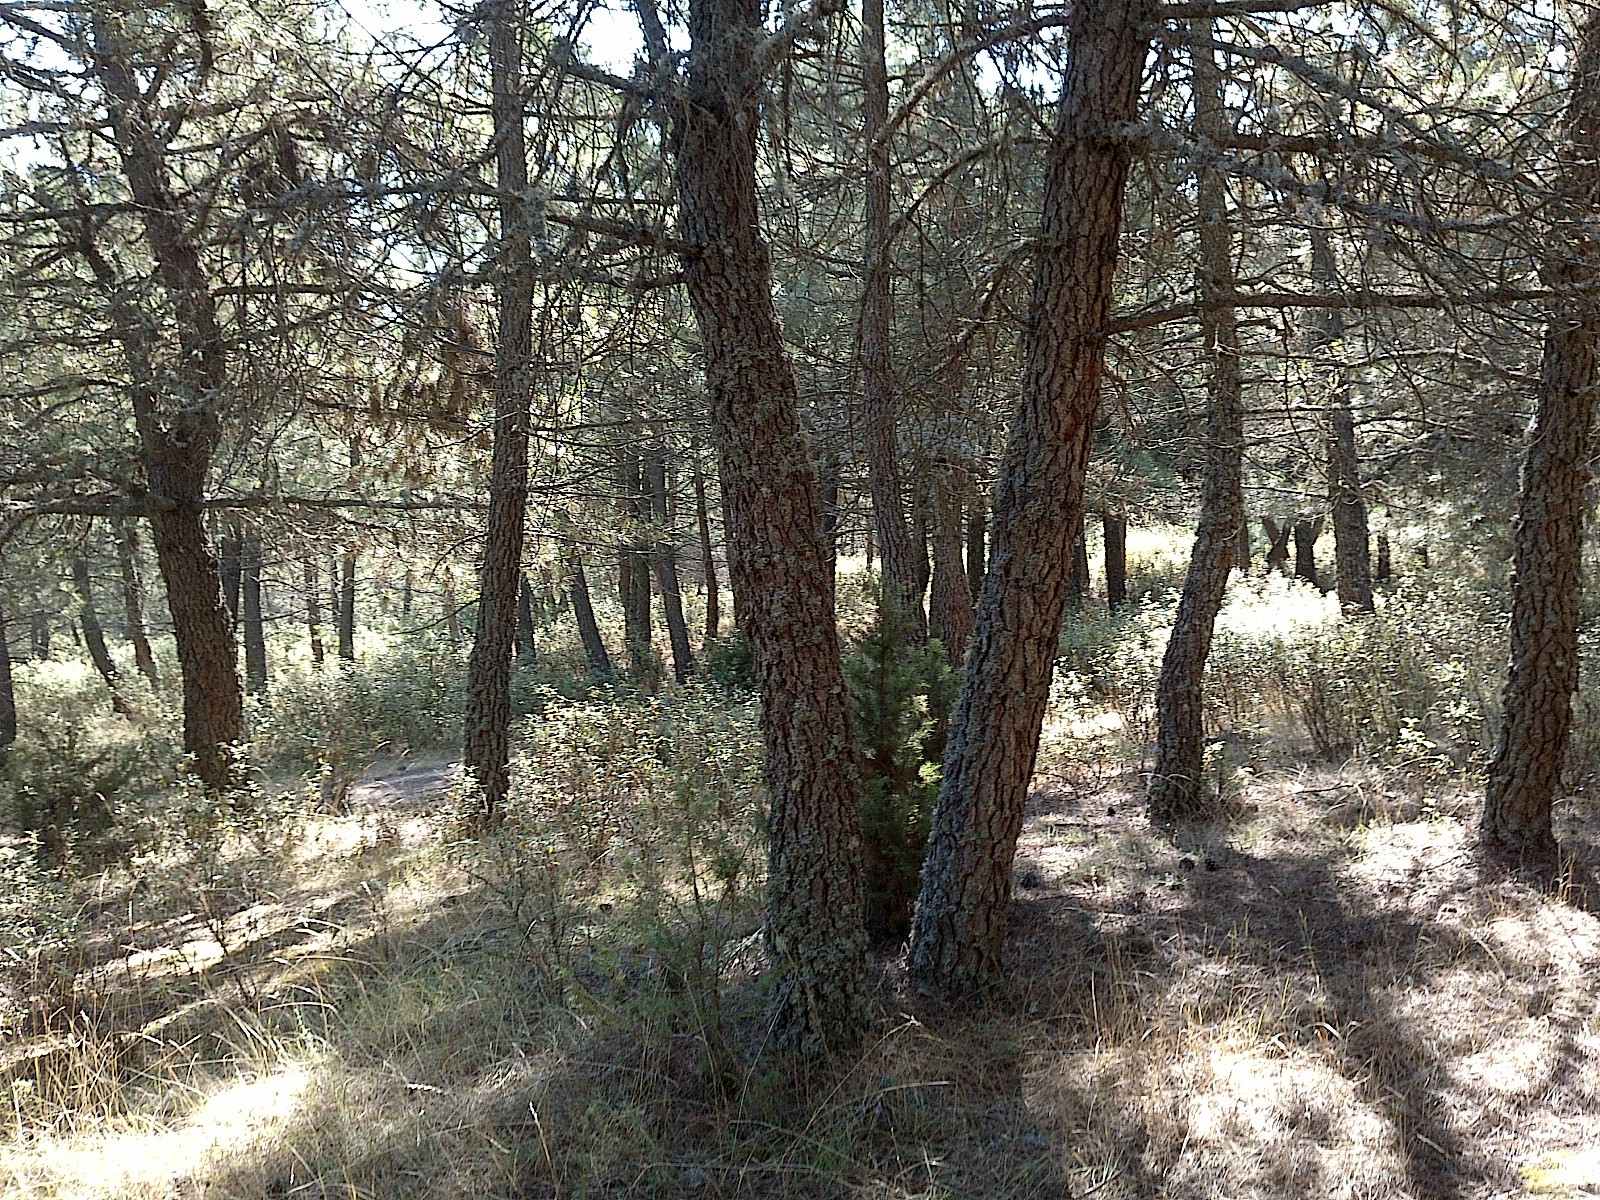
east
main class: Woodland
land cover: Pine dominated coniferous woodland
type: coniferous forest of the mediterranean region
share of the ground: > 75 %
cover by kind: coniferous forest trees 85 %, shrubs 10 %, lichens and mosses 5 %
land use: Forestry
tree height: > 5 m
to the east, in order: Pine dominated coniferous woodland; Tracks; Pine dominated coniferous woodland; Shrubland with sparse tree cover; Tracks; Pine dominated coniferous woodland
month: July
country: ES
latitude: 41.7746
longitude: -3.1476
